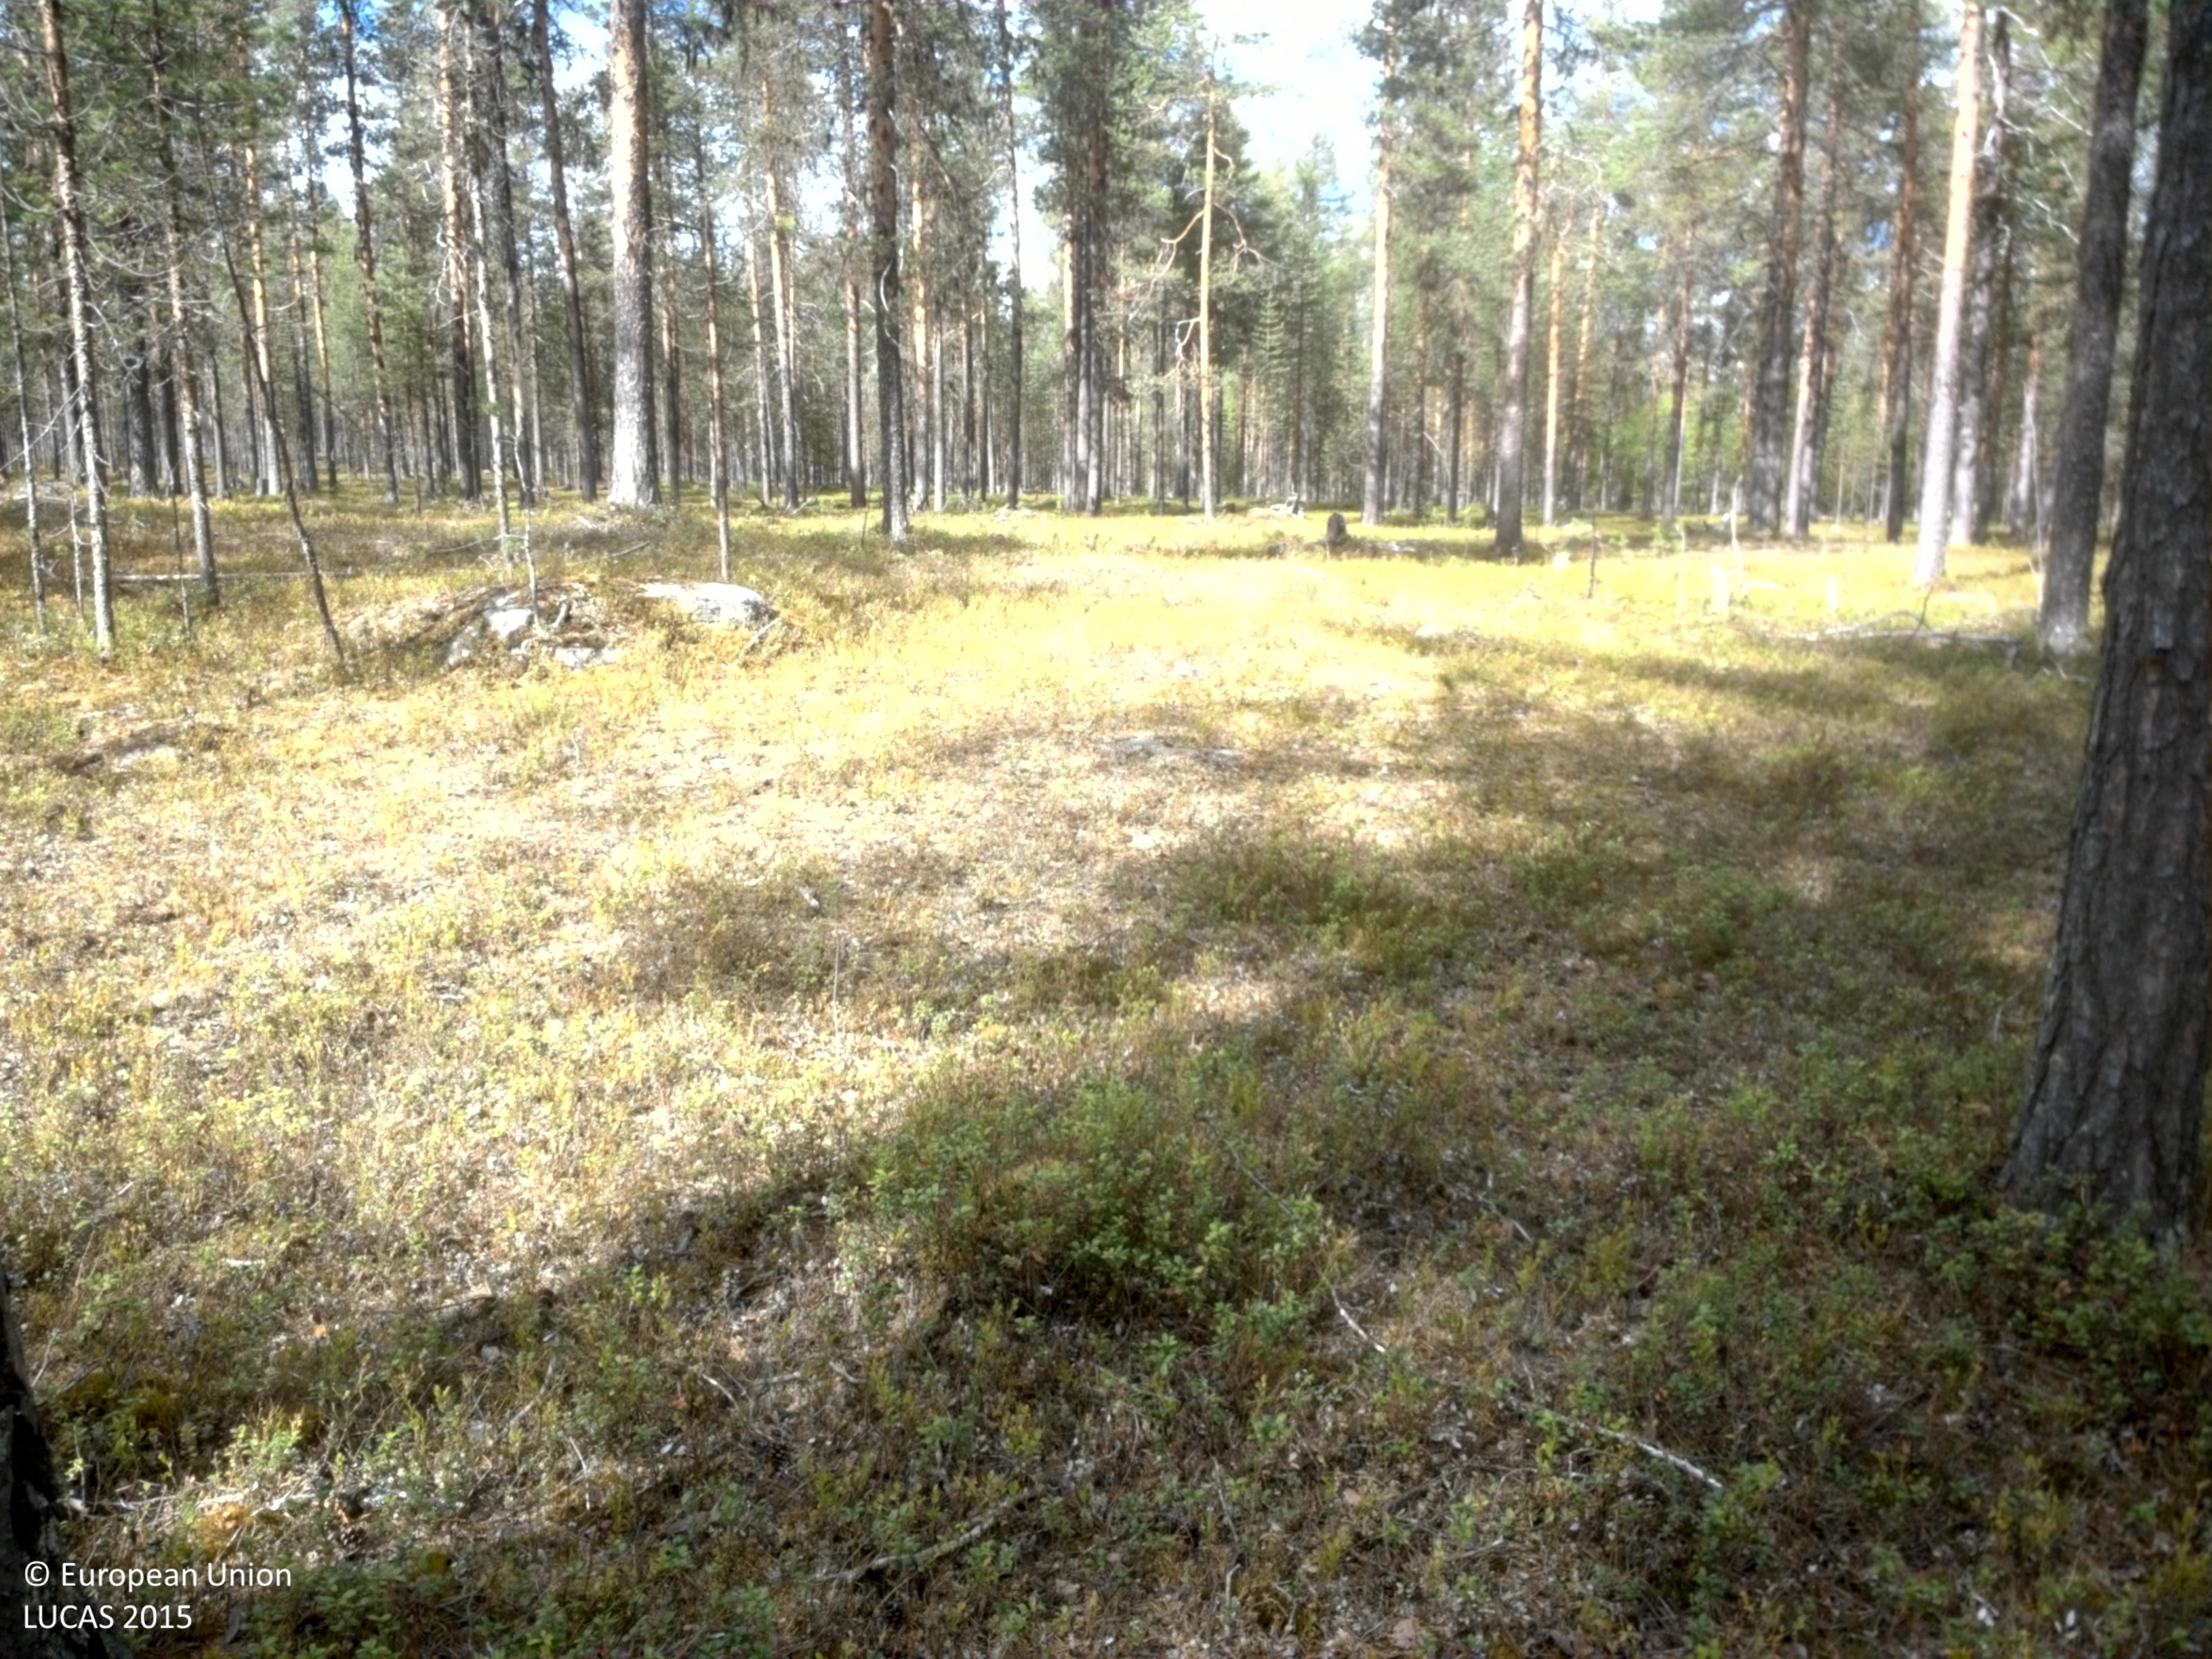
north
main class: Woodland
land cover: Pine dominated coniferous woodland
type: boreal forest
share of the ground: 25 - 50 %
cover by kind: shrubs 65 %, coniferous forest trees 25 %, lichens and mosses 10 %
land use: Forestry
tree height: > 5 m
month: June
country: SE
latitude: 66.8967
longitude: 21.9510
